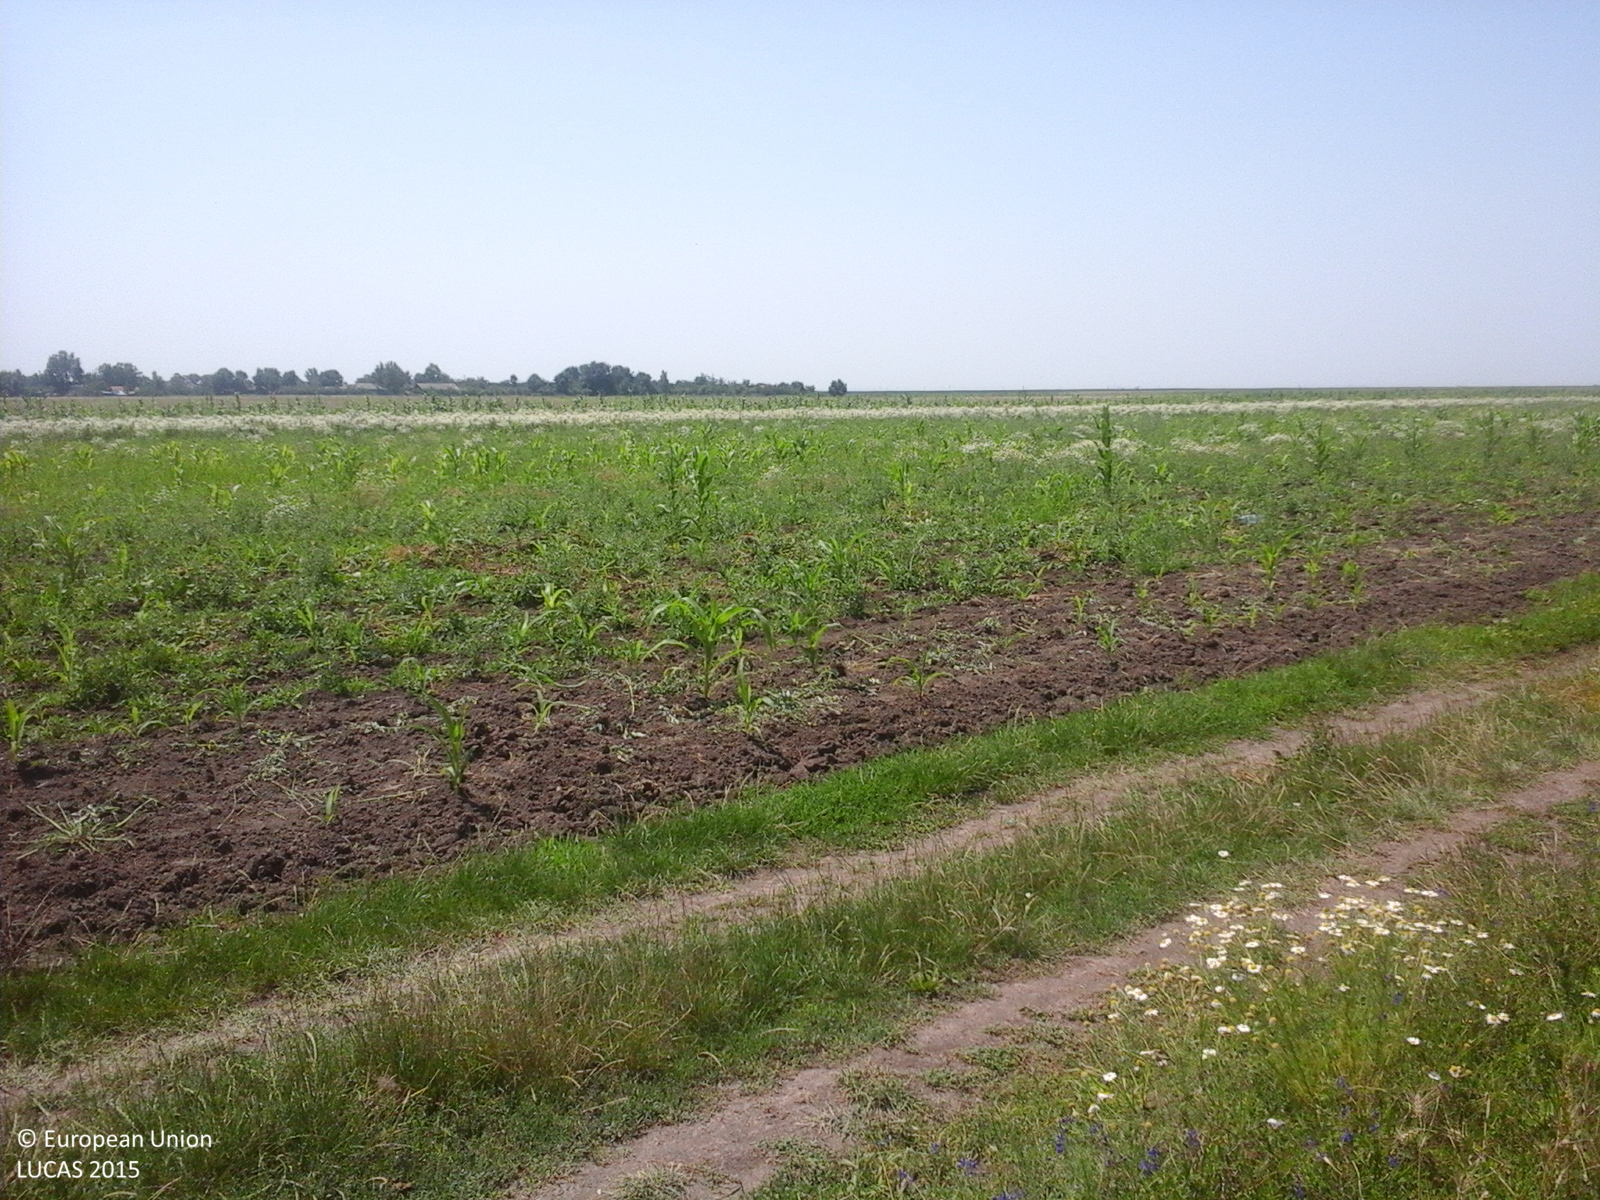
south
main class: Cropland
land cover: Mixed cereals for fodder
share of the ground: > 75 %
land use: Agriculture (excluding fallow land and kitchen gardens)
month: July
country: RO
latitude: 44.4587
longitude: 24.8963
